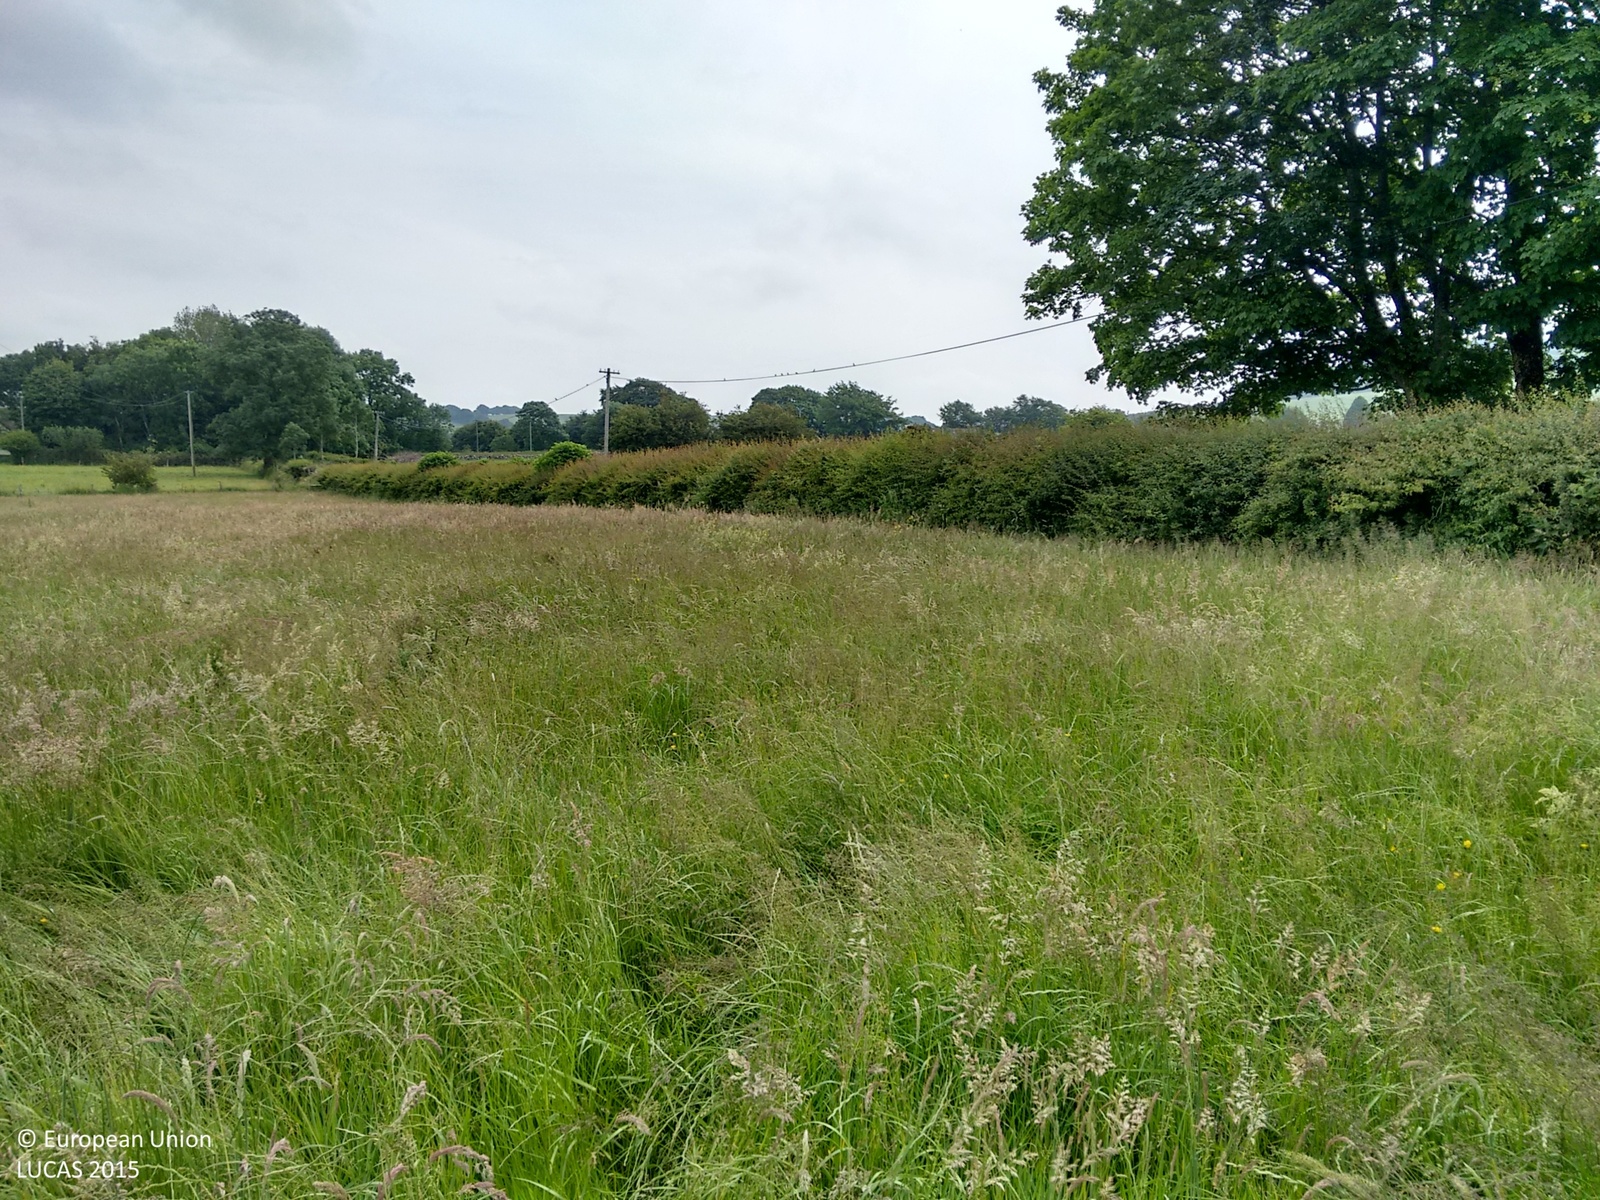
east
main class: Grassland
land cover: Grassland without tree/shrub cover
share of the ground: > 75 %
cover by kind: herbaceous plants 100 %
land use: Agriculture (excluding fallow land and kitchen gardens)
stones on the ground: < 10 %
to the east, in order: Grassland without tree/shrub cover; Managed hedges; Paved roads, cycling and walking lanes; Electric lines; Managed hedges; Grassland without tree/shrub cover; Managed hedges; Grassland without tree/shrub cover; Electric lines; Grassland without tree/shrub cover
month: July
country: IE
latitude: 53.7531
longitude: -7.1158
